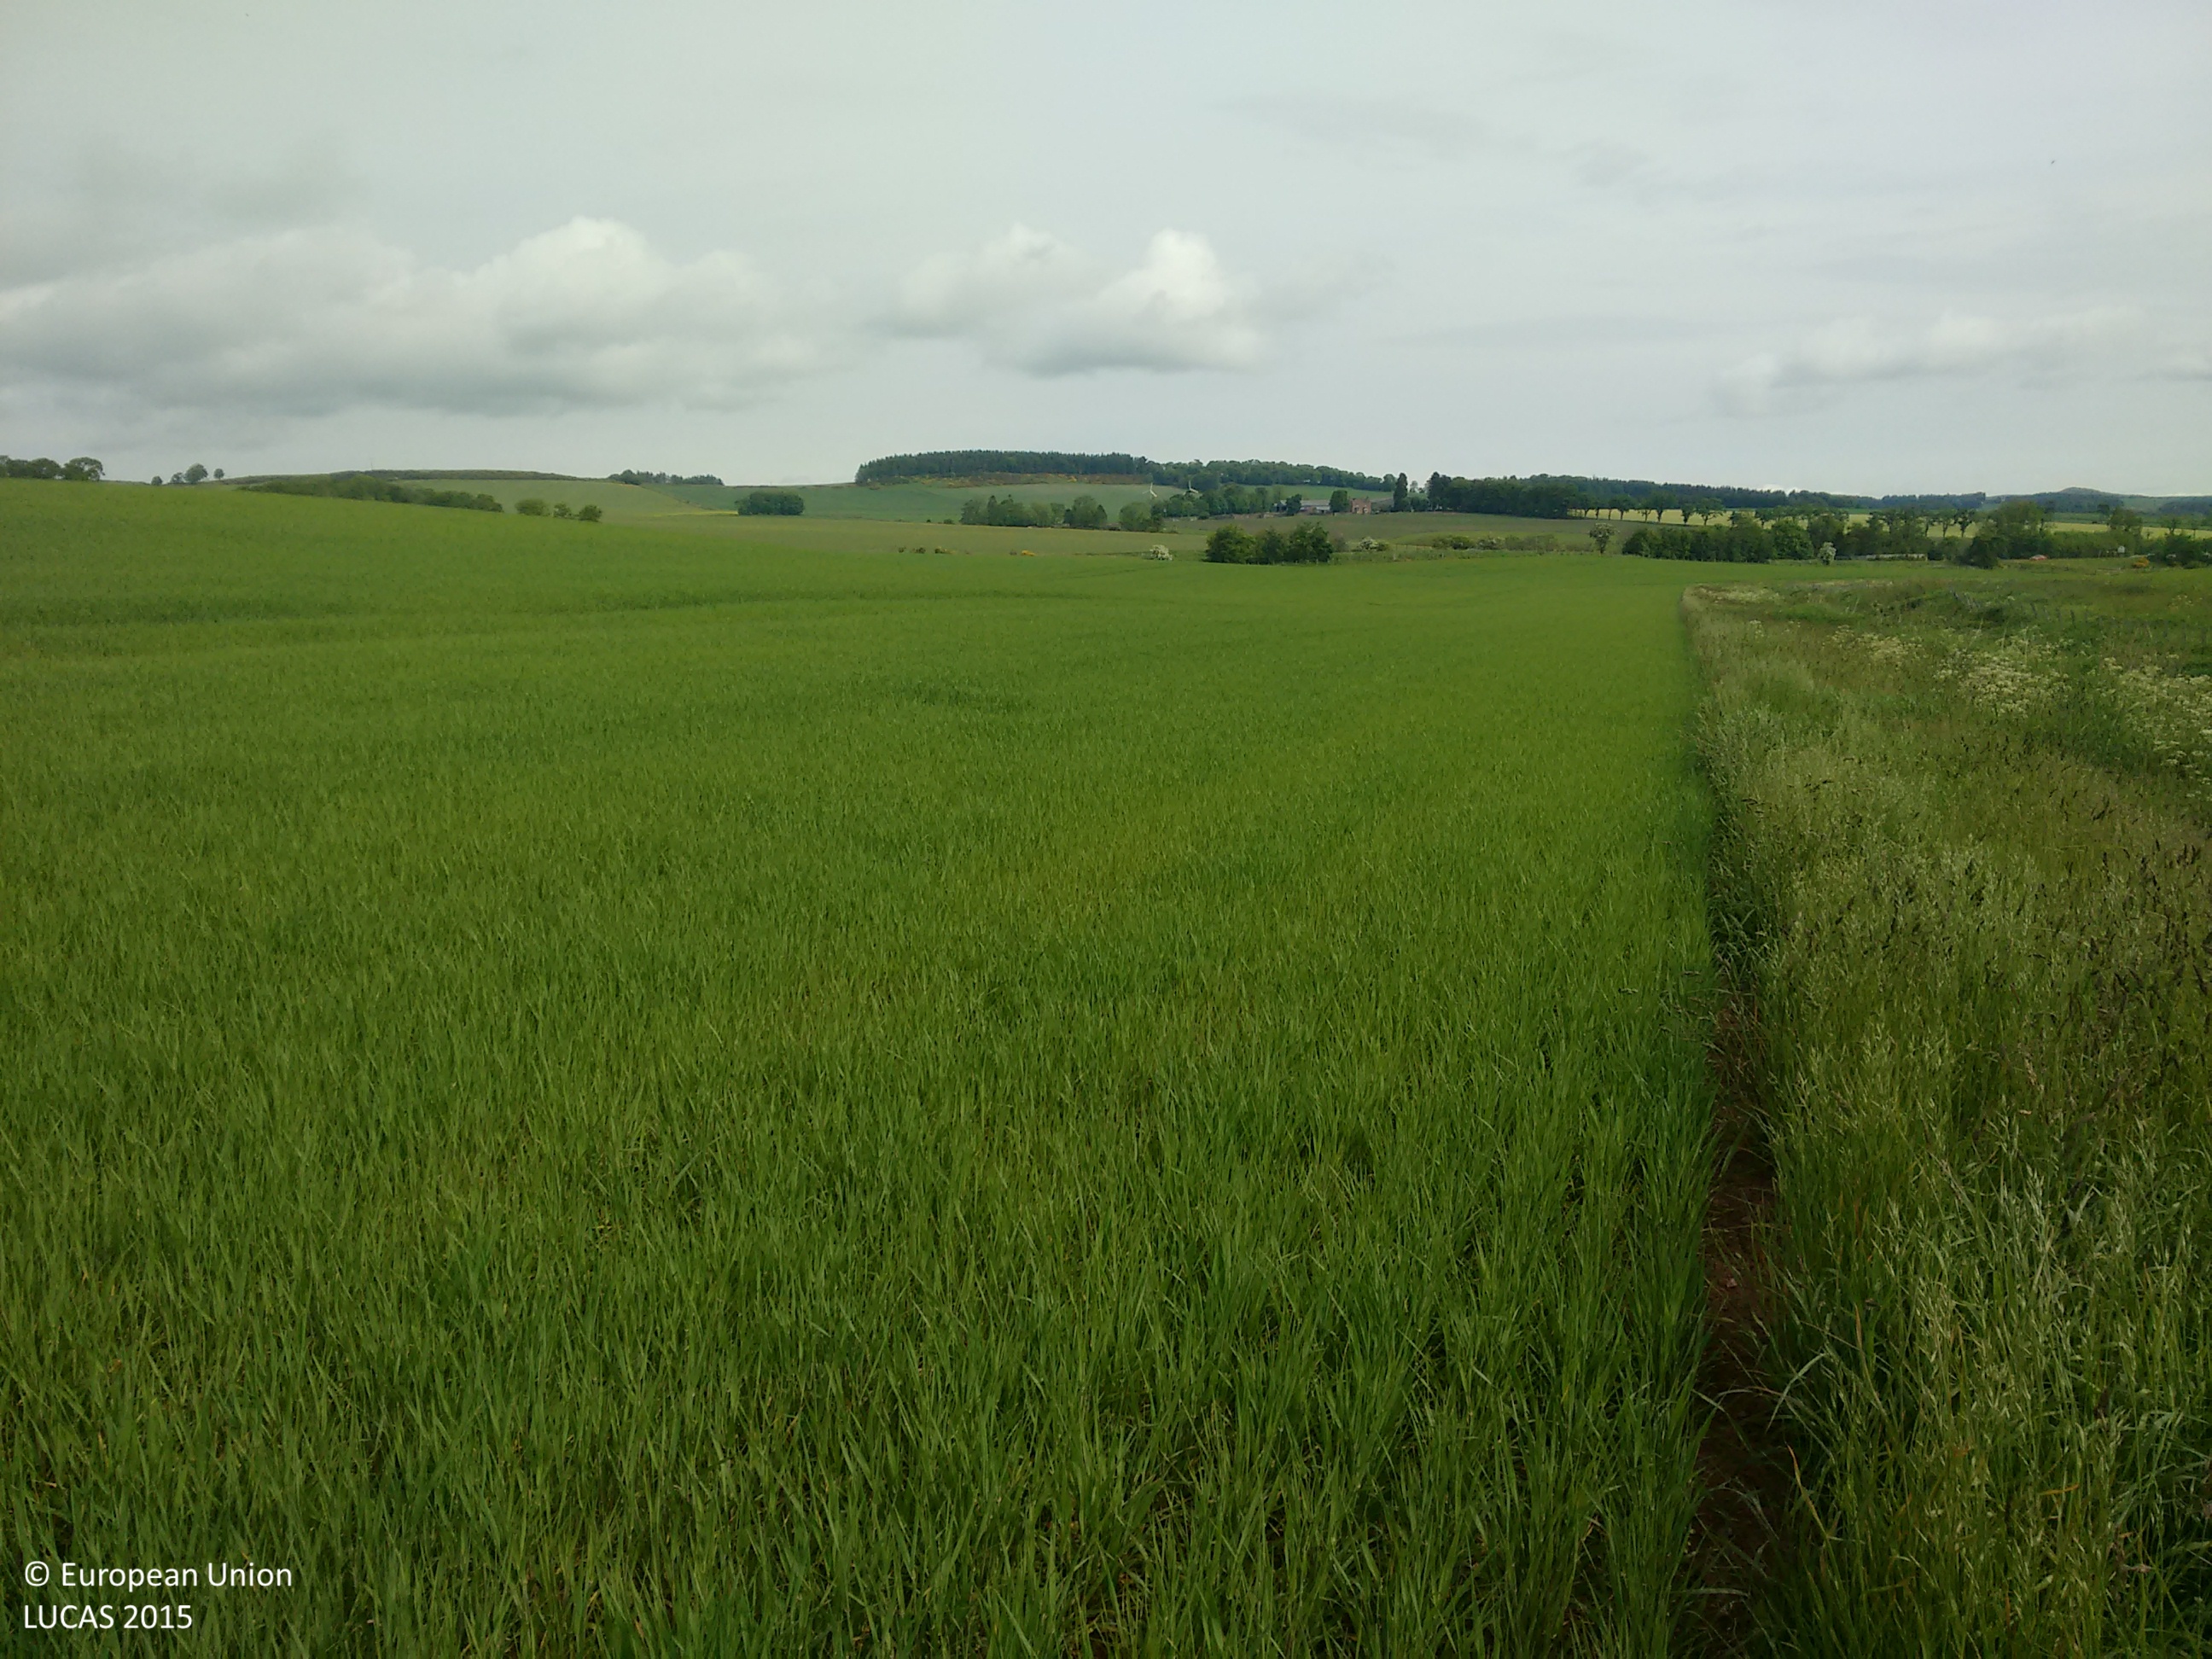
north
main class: Cropland
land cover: Barley
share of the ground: > 75 %
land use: Agriculture (excluding fallow land and kitchen gardens)
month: June
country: GB
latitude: 56.2520
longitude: -3.3566
